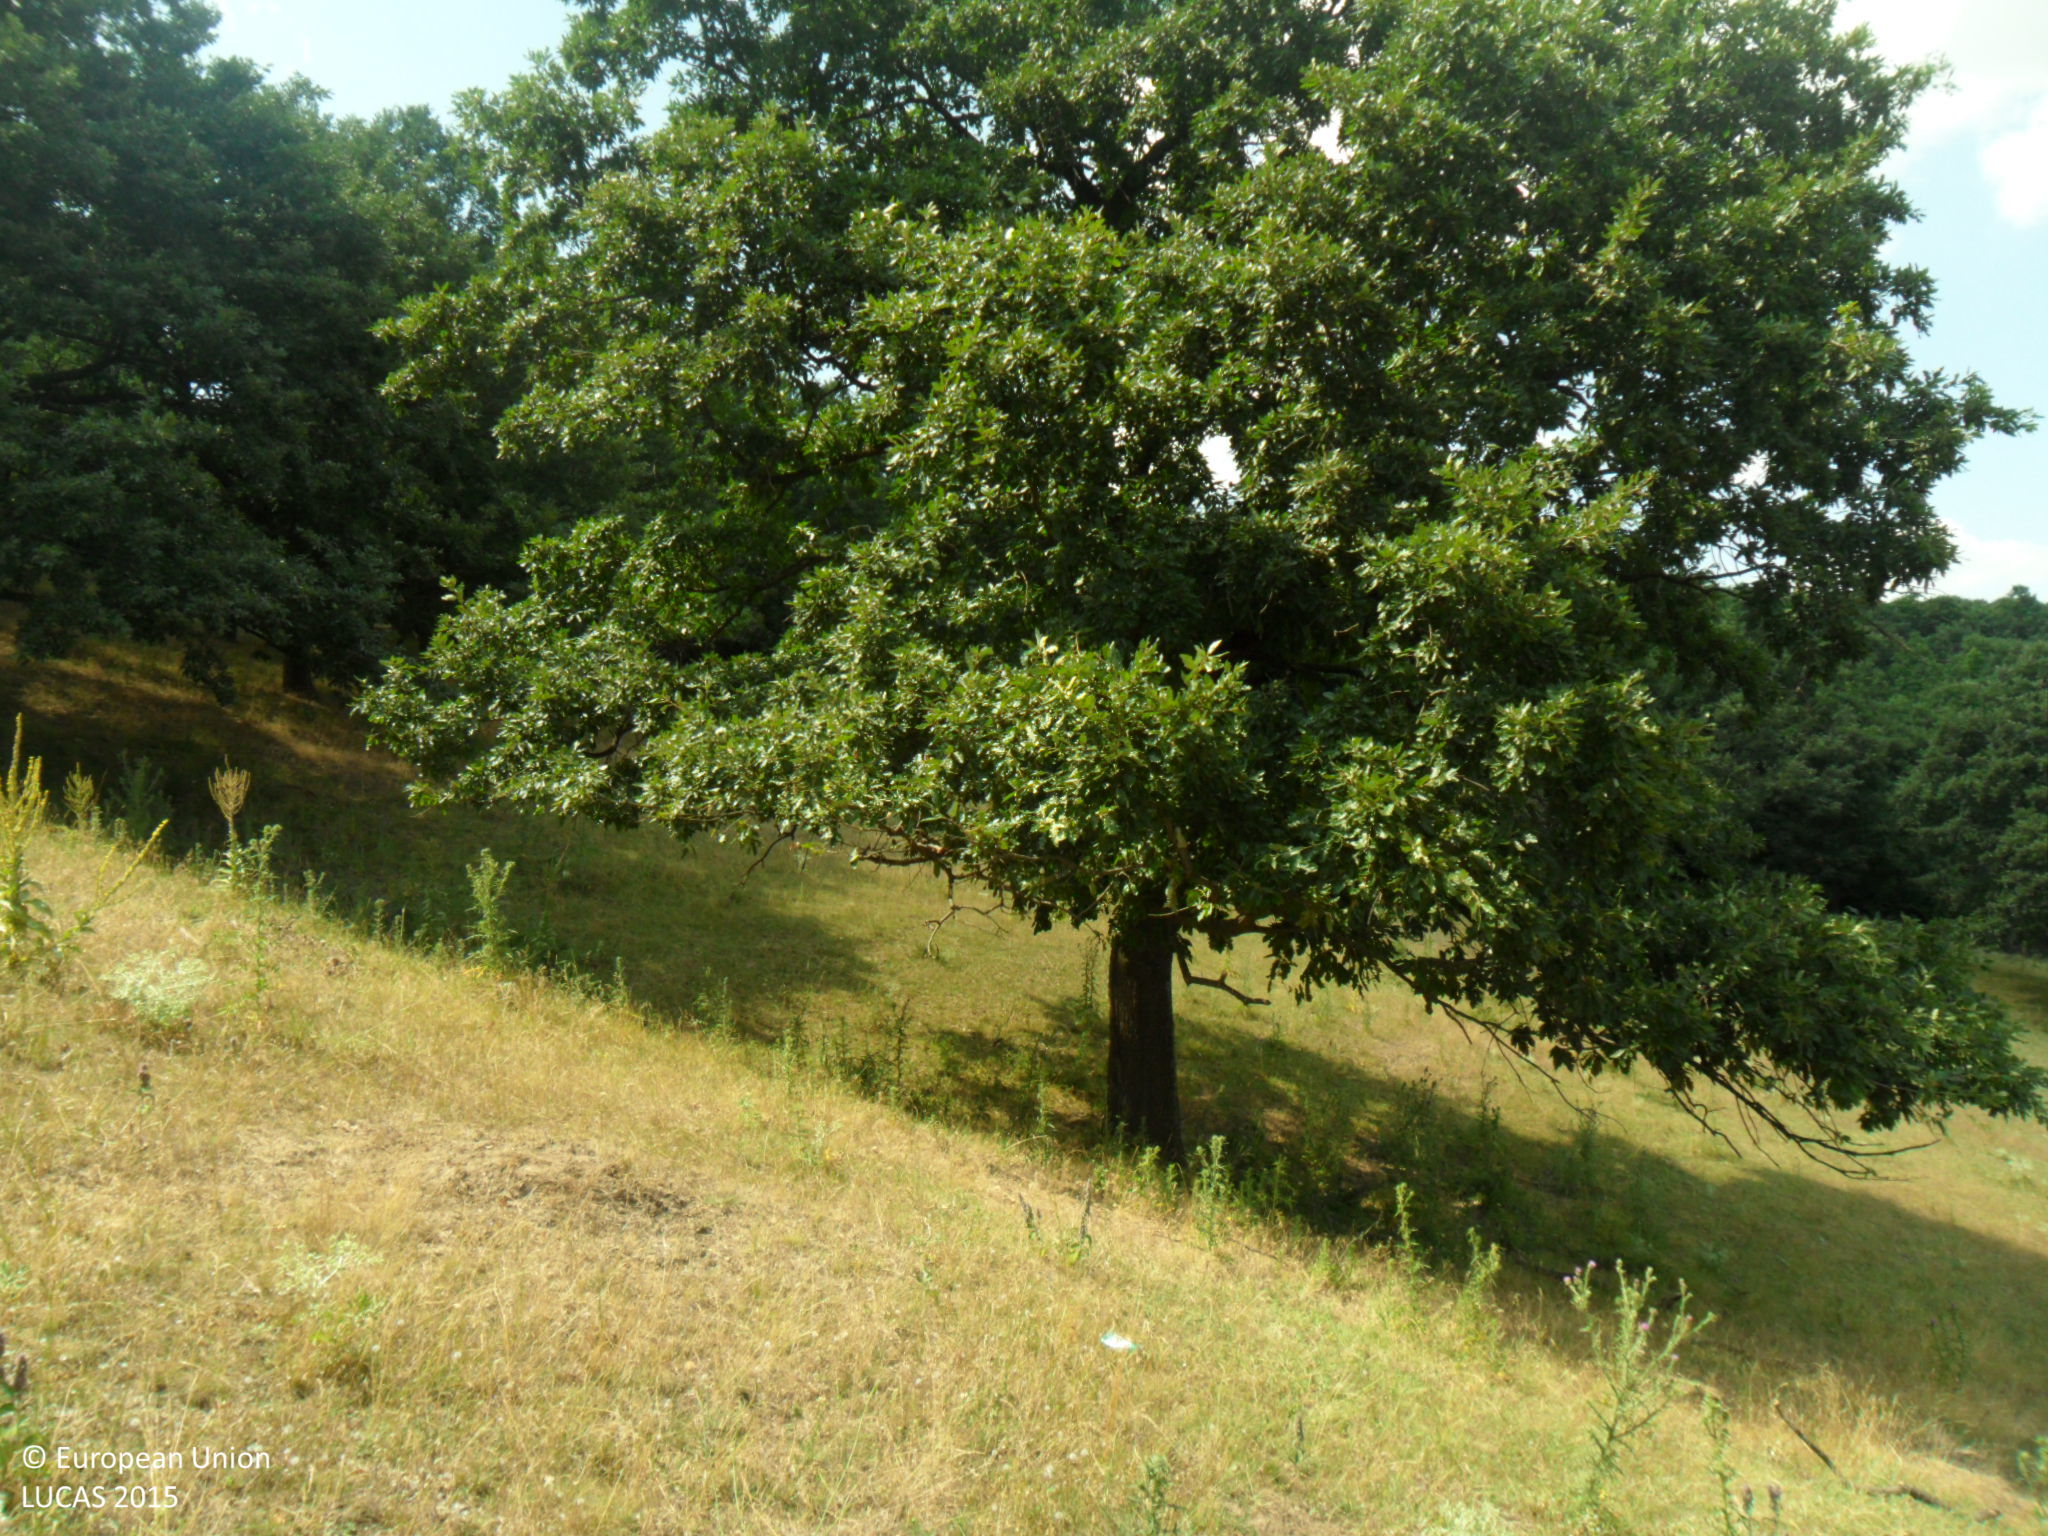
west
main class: Grassland
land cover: Grassland with sparse tree/shrub cover
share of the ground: > 75 %
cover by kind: herbaceous plants 90 %, broadleaved forest trees 5 %, shrubs 5 %
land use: Forestry
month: July
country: BG
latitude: 43.6438
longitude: 27.2714
